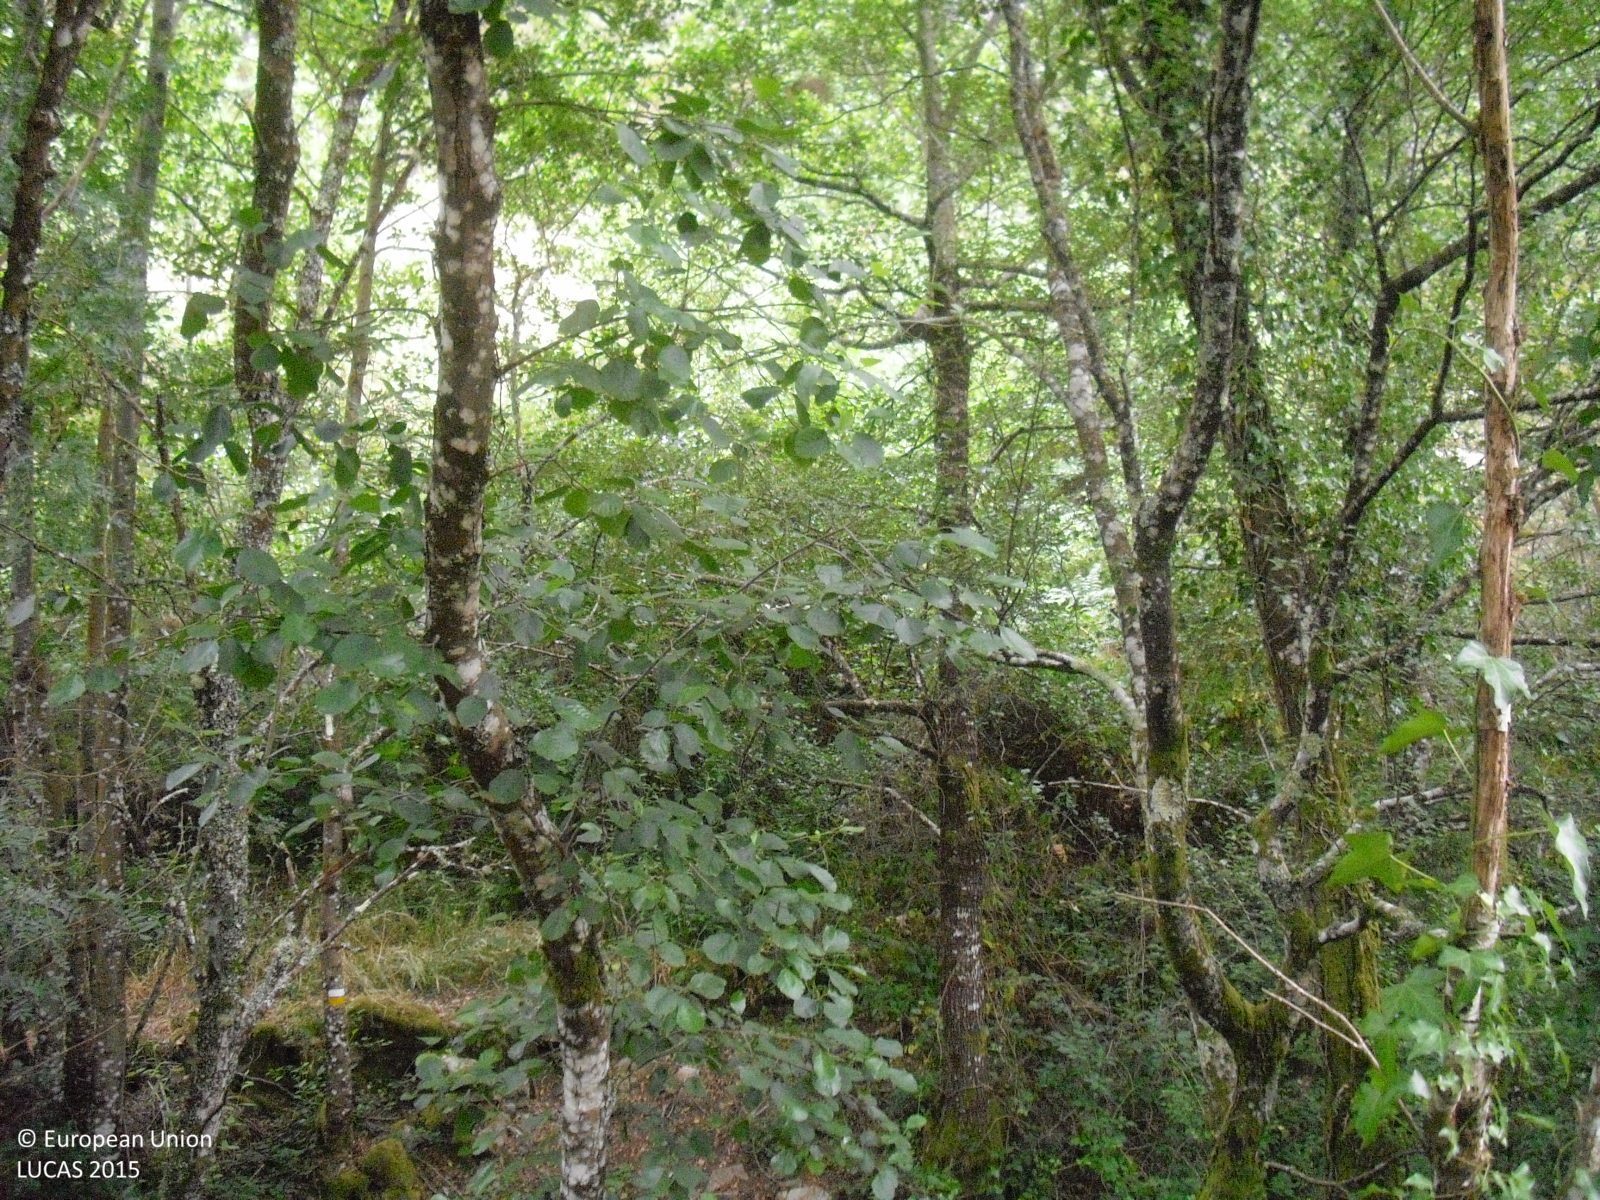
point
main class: Woodland
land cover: Broadleaved woodland
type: thermophilous deciduous forest
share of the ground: 50 - 75 %
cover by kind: broadleaved forest trees 60 %, shrubs 30 %, consolidated bare surface 10 %
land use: Semi-natural and natural areas not in use
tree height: > 5 m
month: July
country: ES
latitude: 42.5169
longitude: -7.7122
